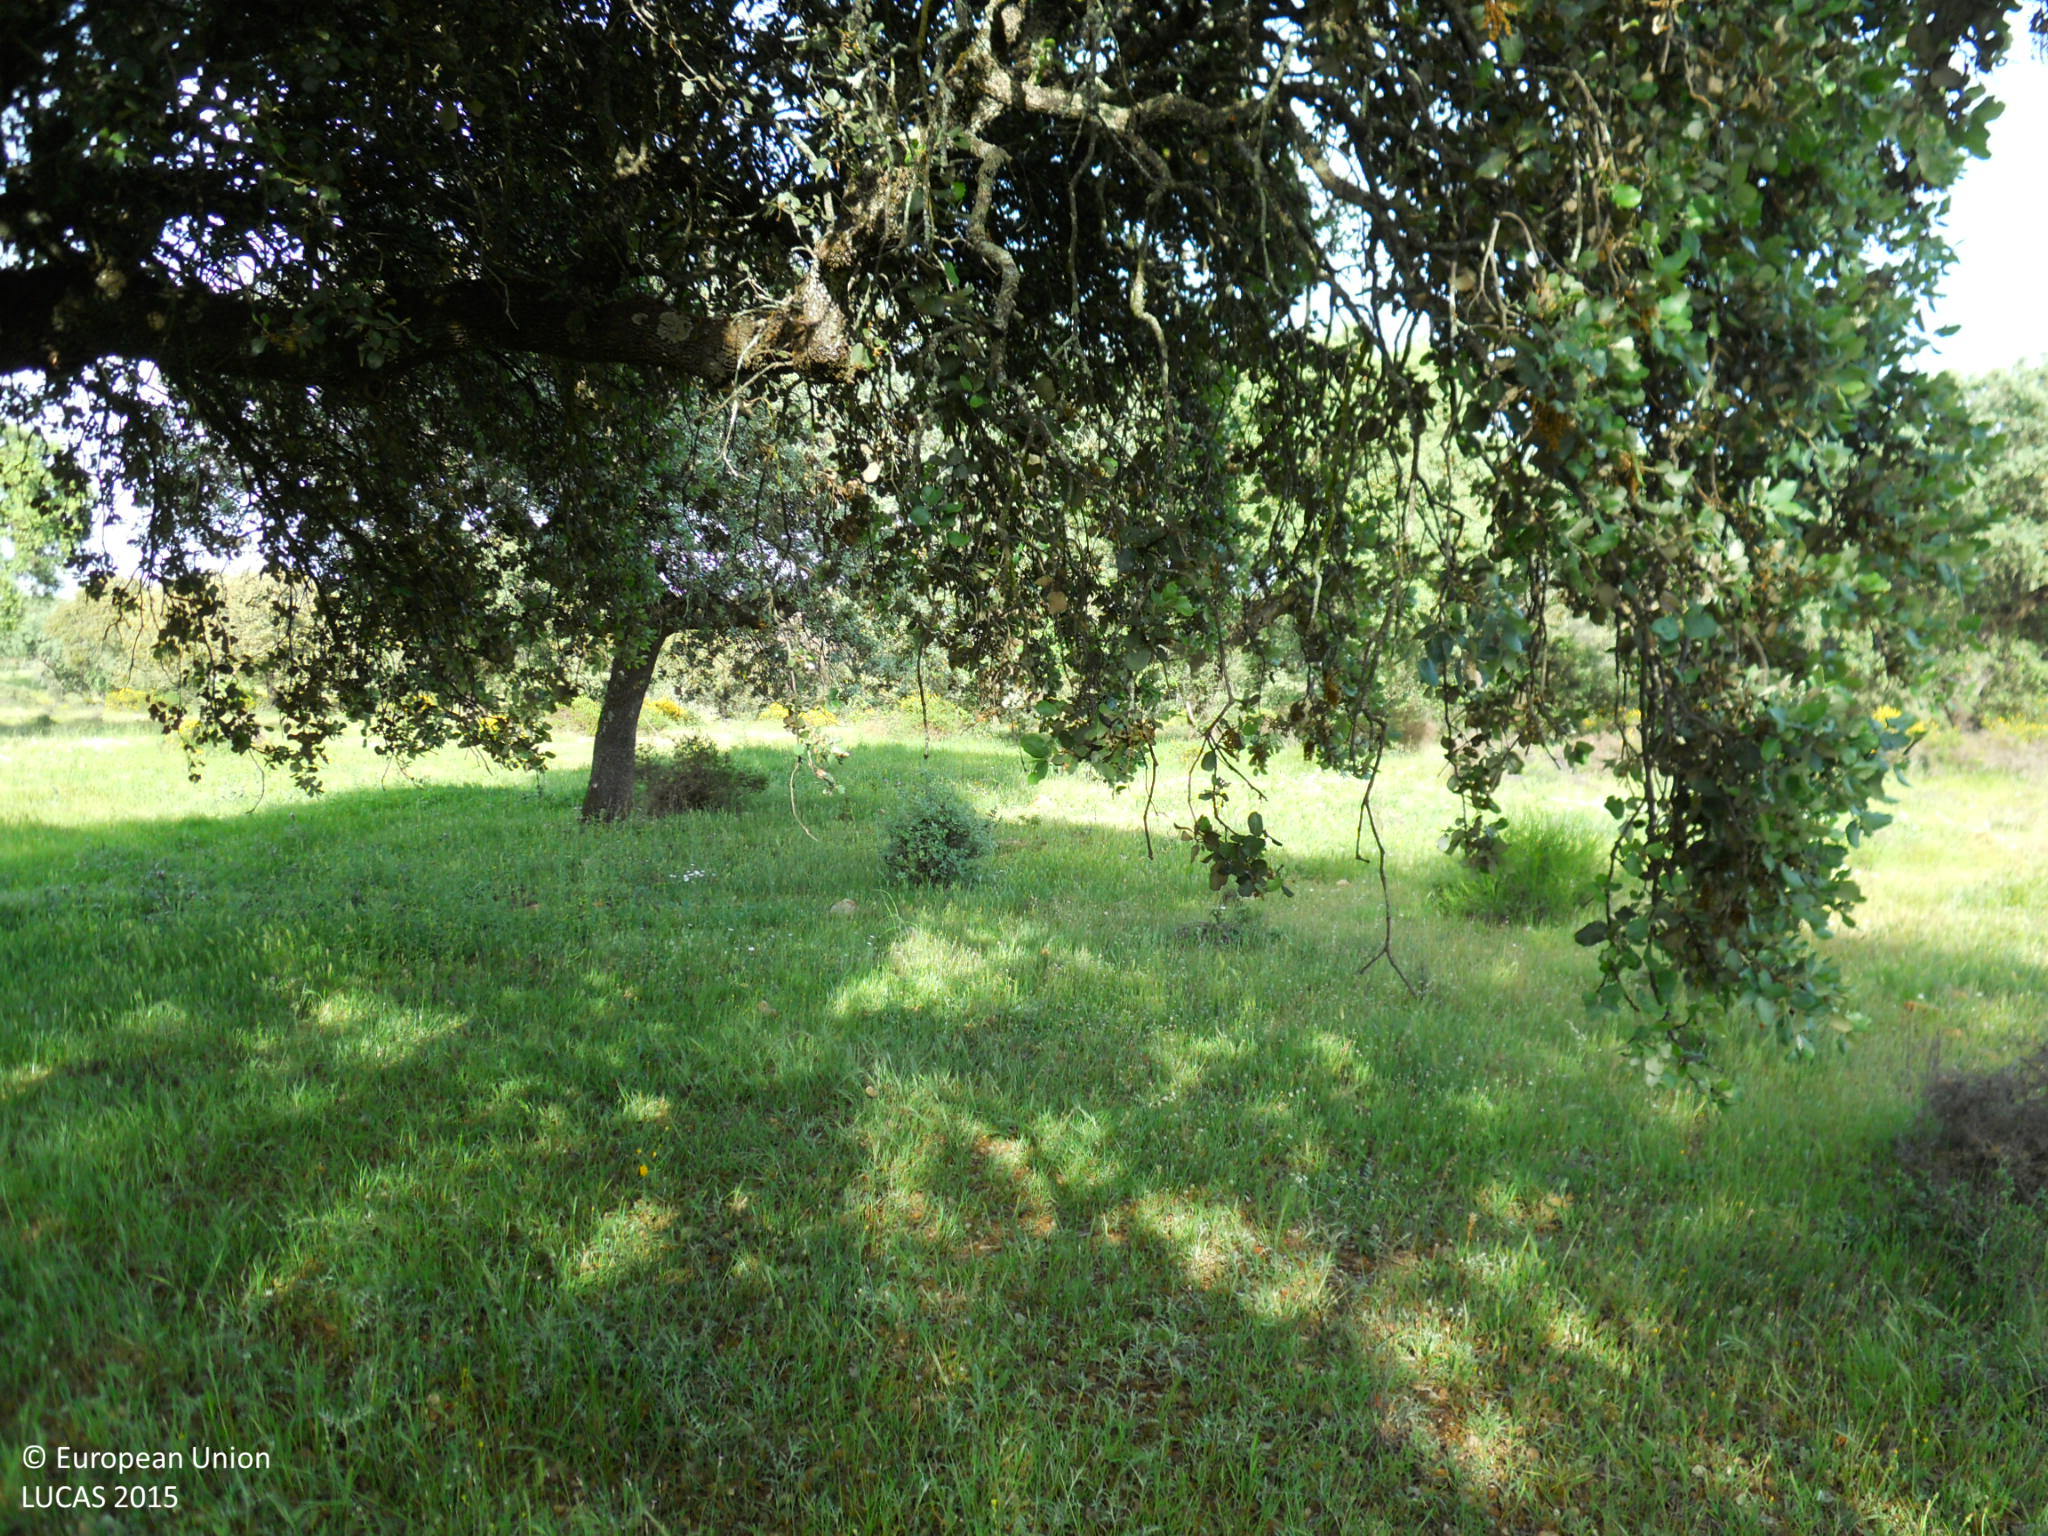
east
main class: Woodland
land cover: Broadleaved woodland
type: broadleaved evergreen forest
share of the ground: 50 - 75 %
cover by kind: broadleaved forest trees 50 %, herbaceous plants 50 %
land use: Forestry
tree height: > 5 m
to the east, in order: Broadleaved woodland; Grassland with sparse tree/shrub cover; Broadleaved woodland
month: April
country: ES
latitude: 39.0994
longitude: -6.2824
